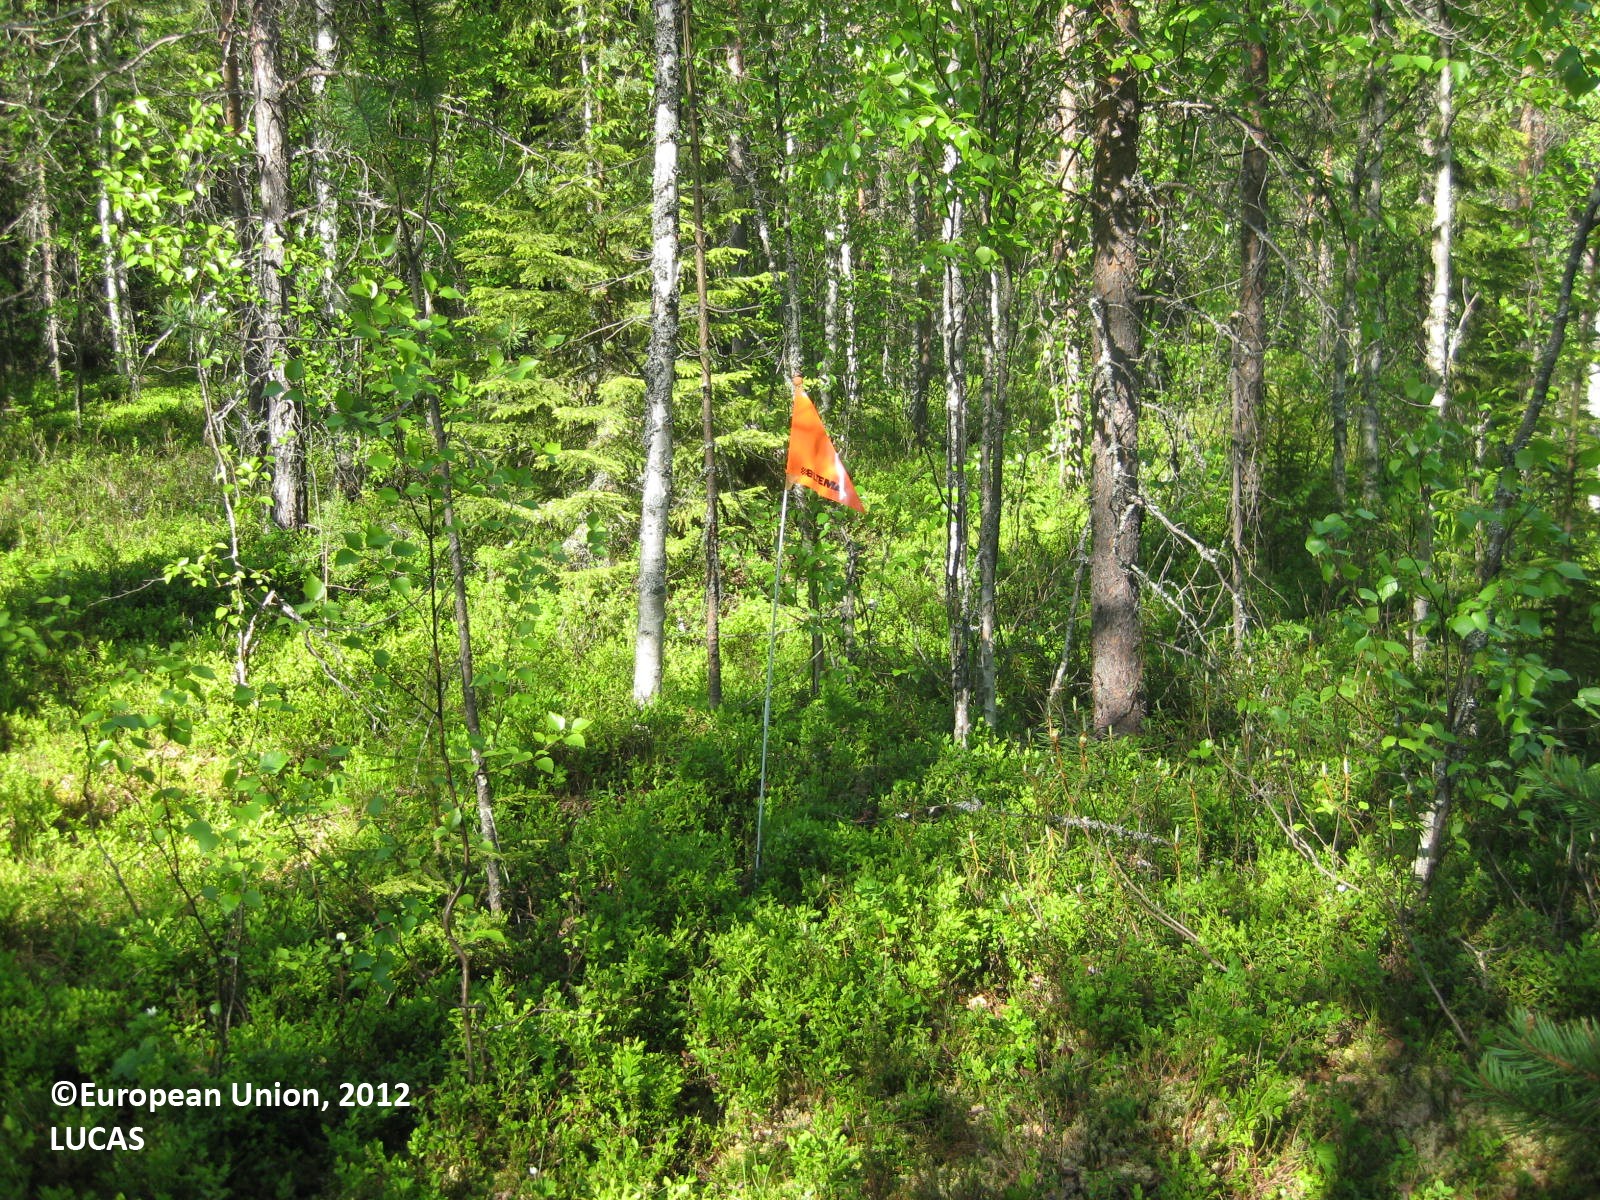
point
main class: Woodland
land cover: Pine dominated mixed woodland
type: boreal forest
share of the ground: > 75 %
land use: Forestry
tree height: > 5 m
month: June
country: FI
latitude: 65.0567
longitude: 29.0818
